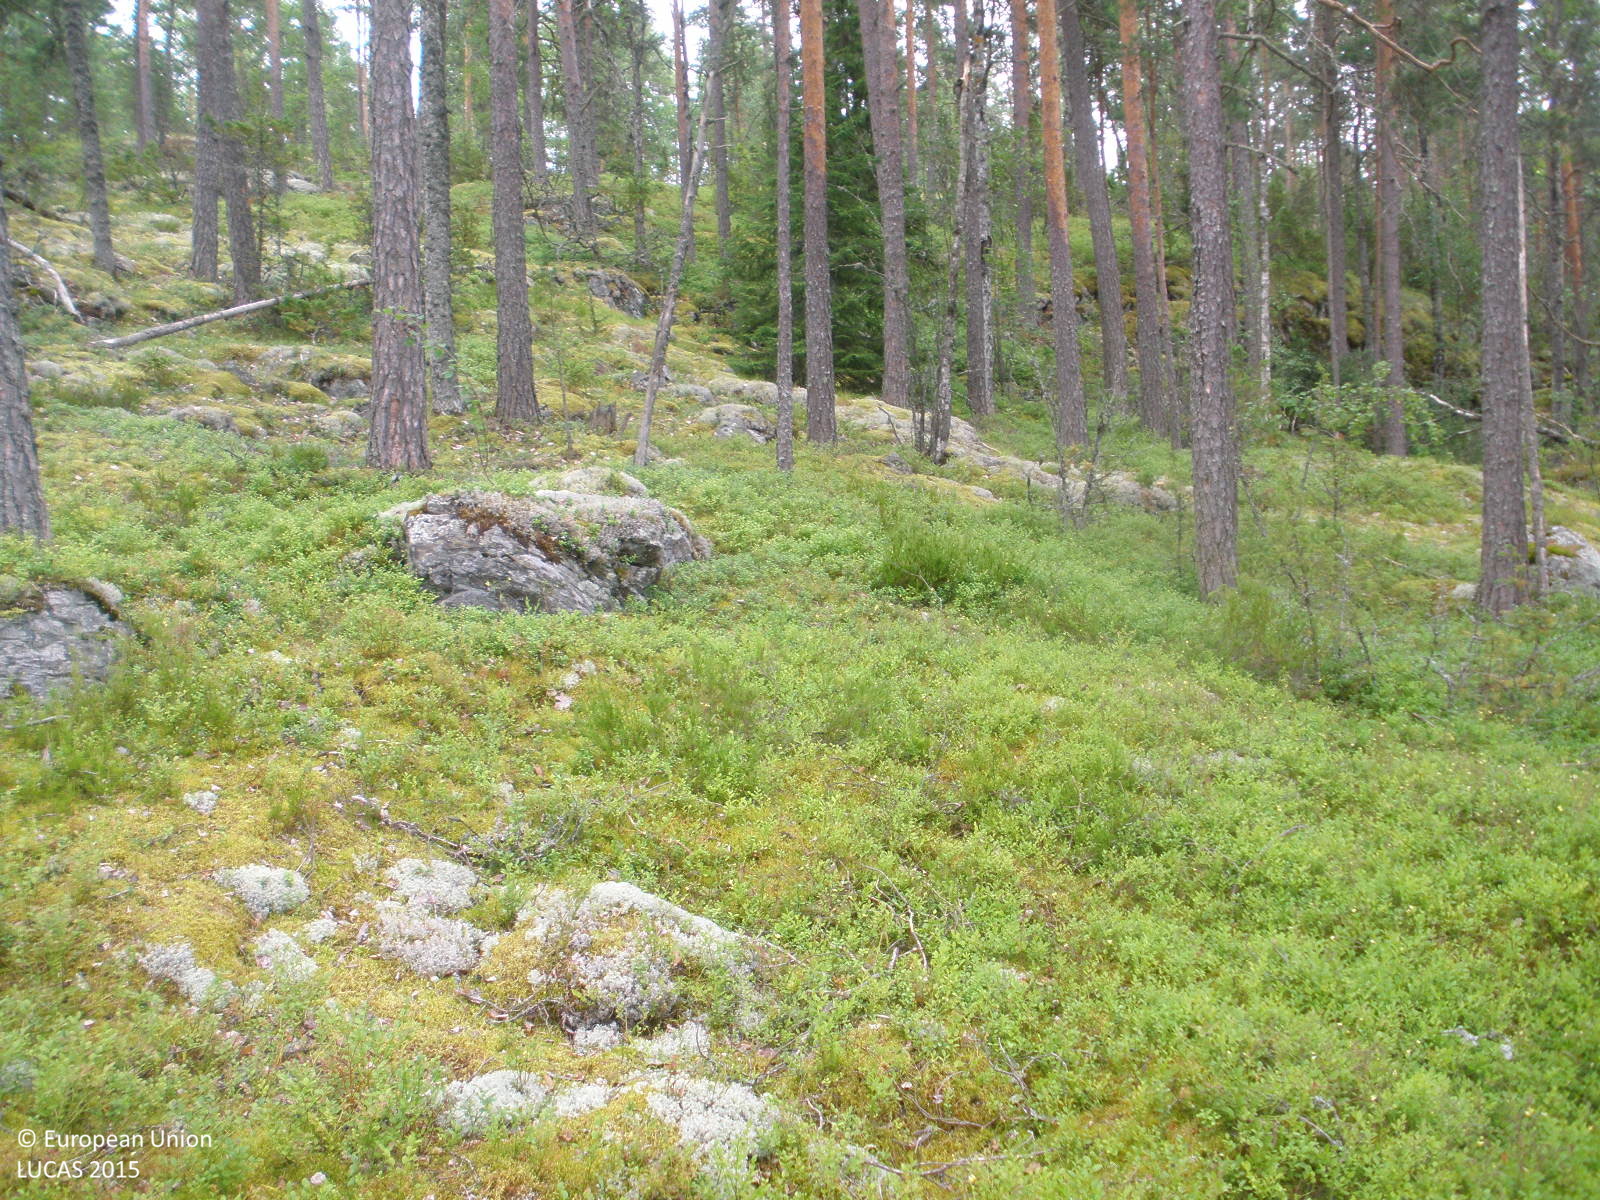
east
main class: Woodland
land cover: Pine dominated coniferous woodland
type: boreal forest
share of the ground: > 75 %
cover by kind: coniferous forest trees 75 %, shrubs 10 %, lichens and mosses 10 %, herbaceous plants 5 %
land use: Forestry
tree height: > 5 m
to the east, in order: Pine dominated coniferous woodland; Pine dominated mixed woodland
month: July
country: FI
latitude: 61.5239
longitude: 24.6345
